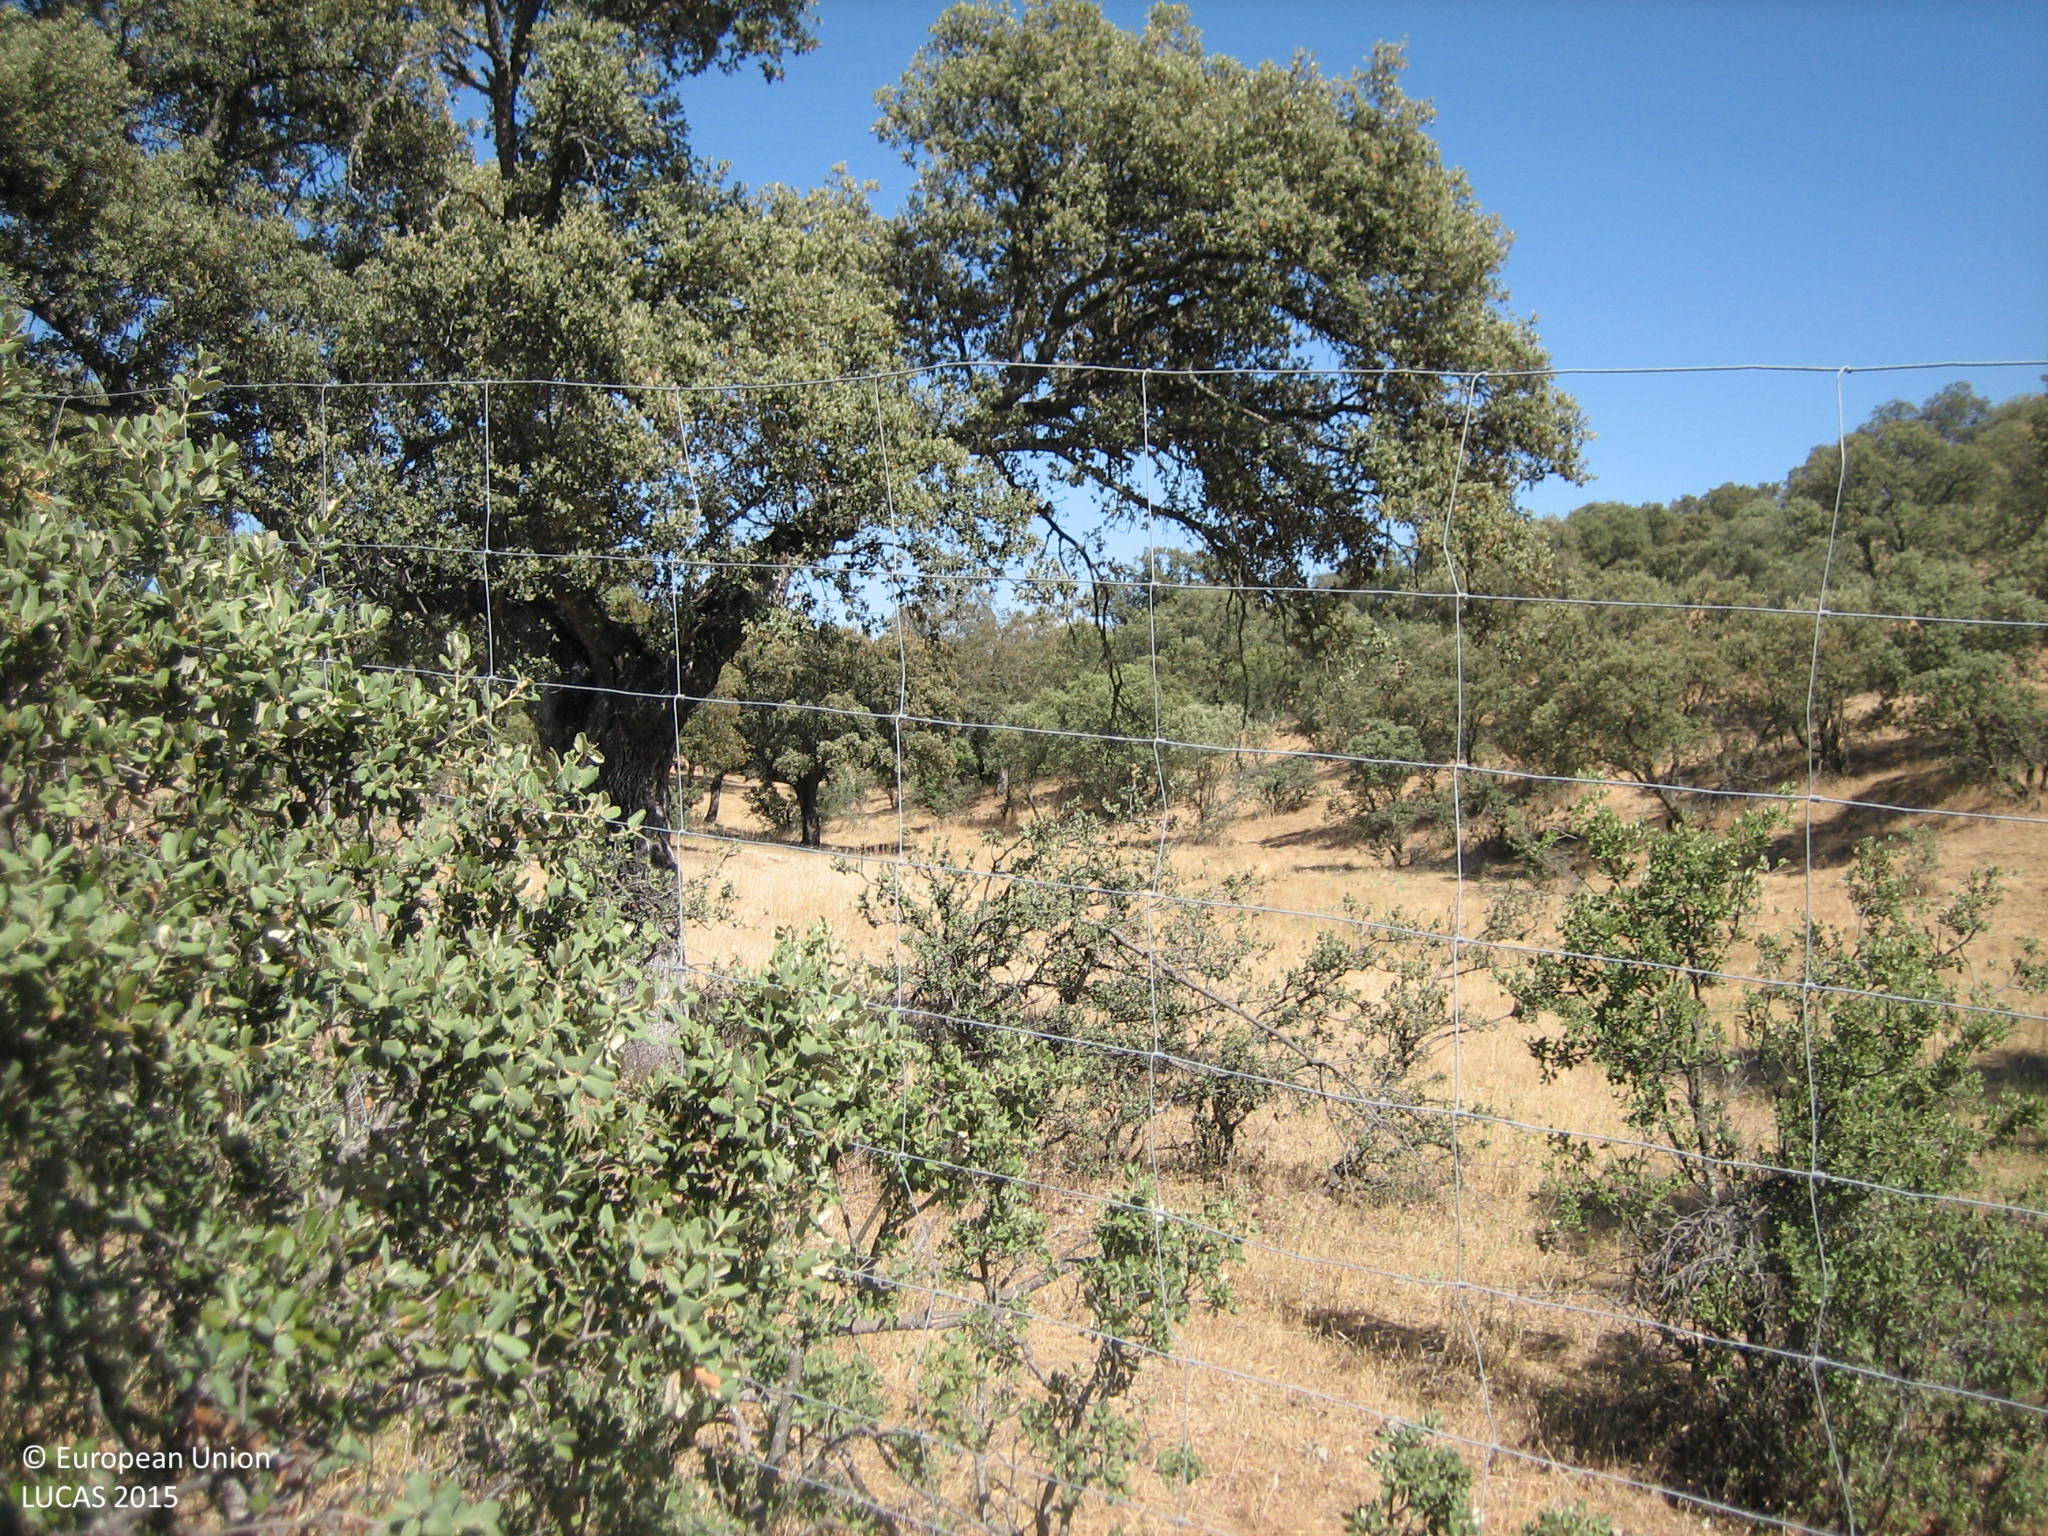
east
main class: Woodland
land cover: Broadleaved woodland
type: broadleaved evergreen forest
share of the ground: 10 - 25 %
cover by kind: herbaceous plants 85 %, broadleaved forest trees 15 %
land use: Forestry
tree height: > 5 m
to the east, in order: Broadleaved woodland
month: May
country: ES
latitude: 38.5103
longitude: -3.9705
